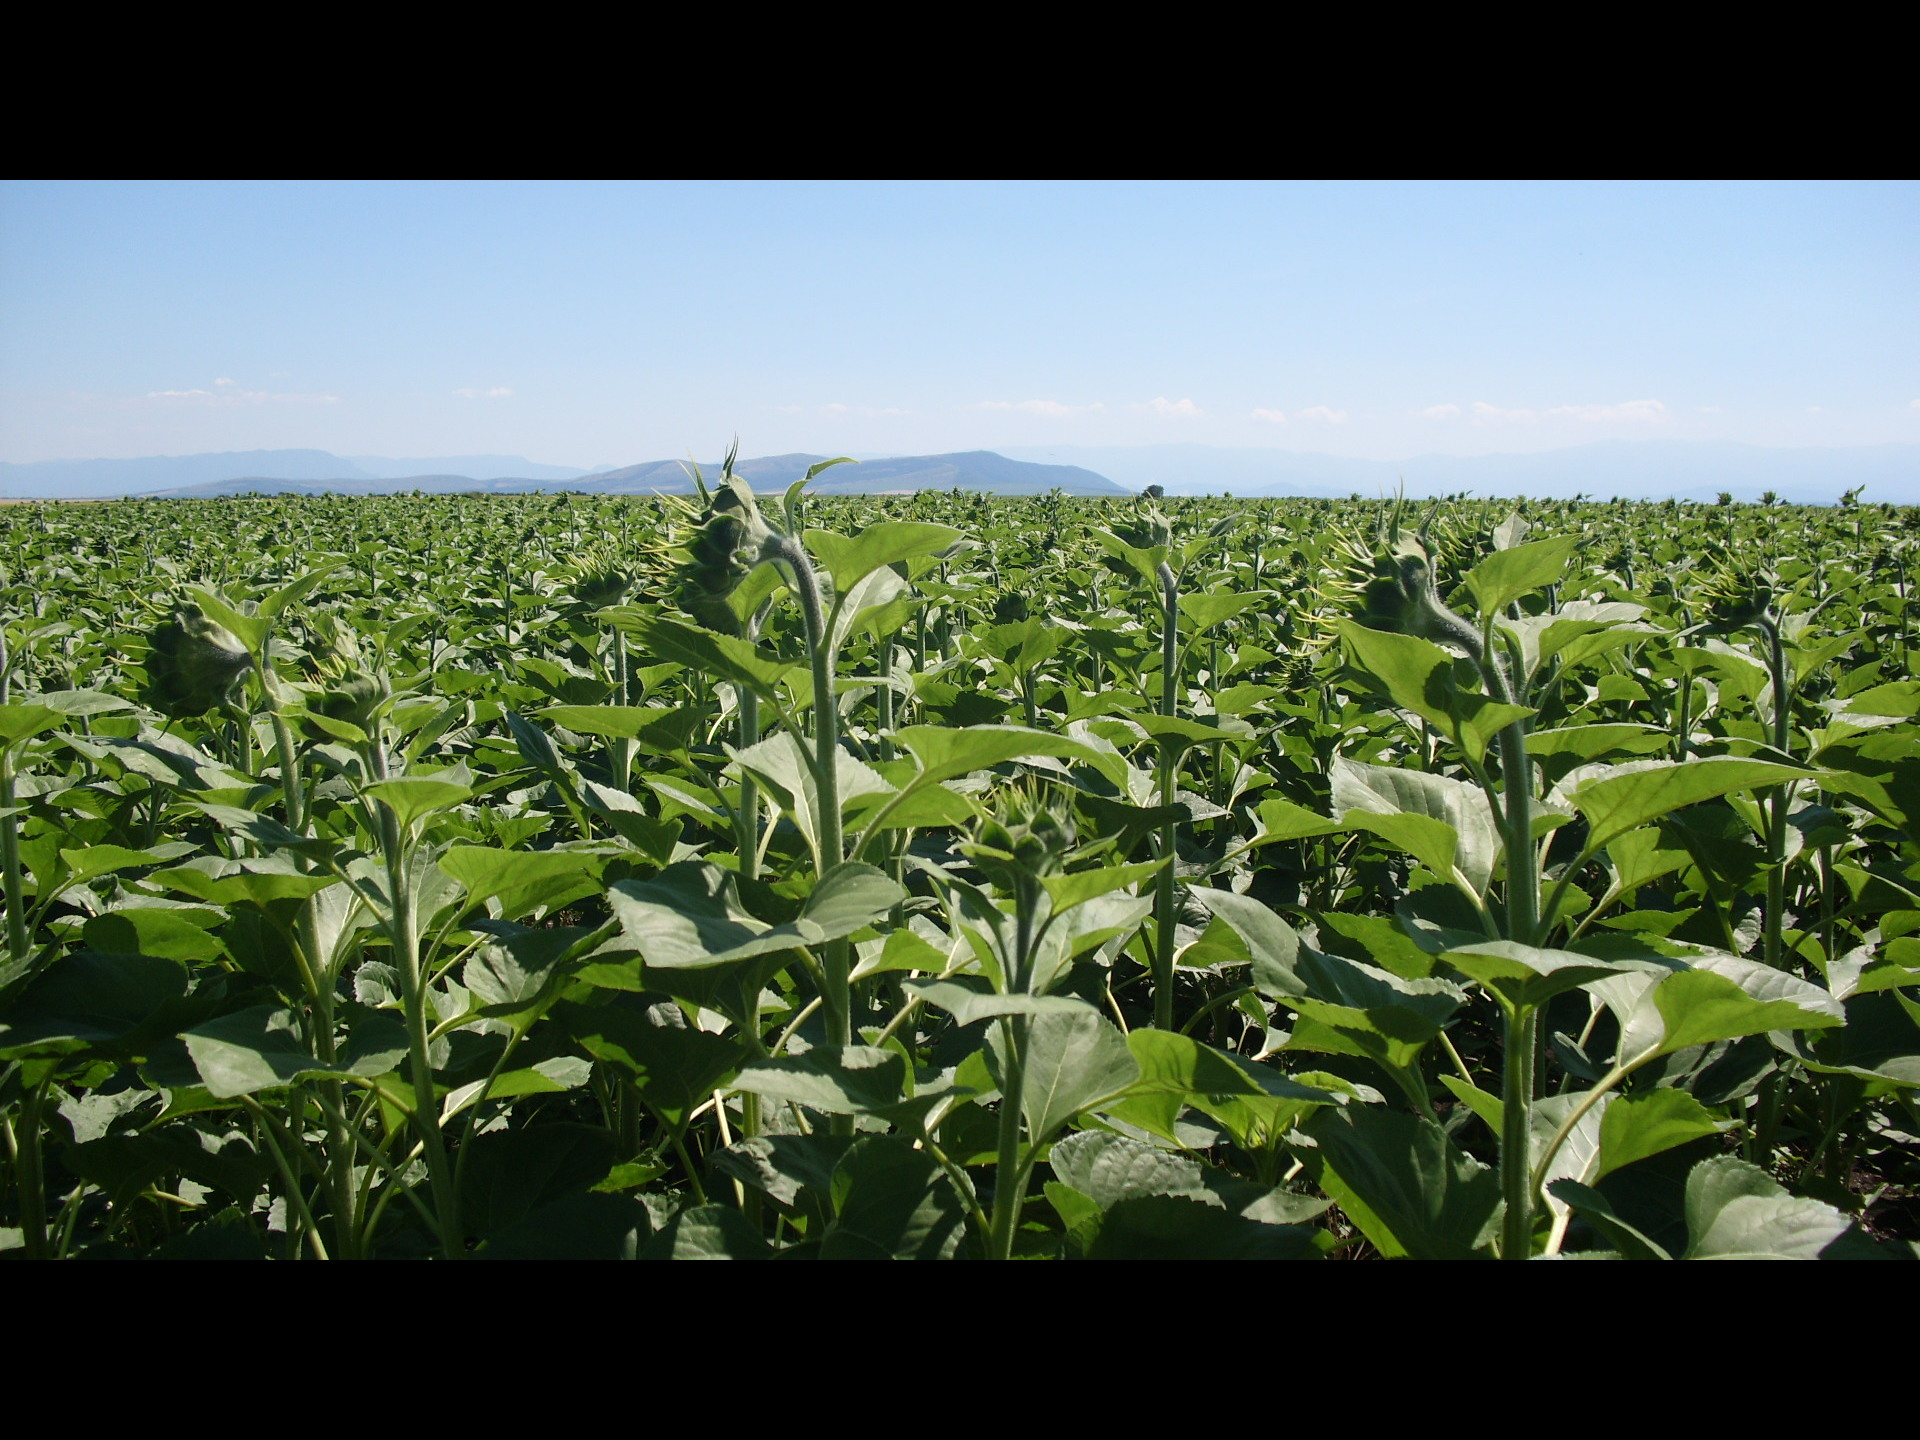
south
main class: Cropland
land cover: Sunflower
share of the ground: > 75 %
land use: Agriculture (excluding fallow land and kitchen gardens)
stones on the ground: < 10 %
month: June
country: BG
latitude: 43.5598
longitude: 23.3259
